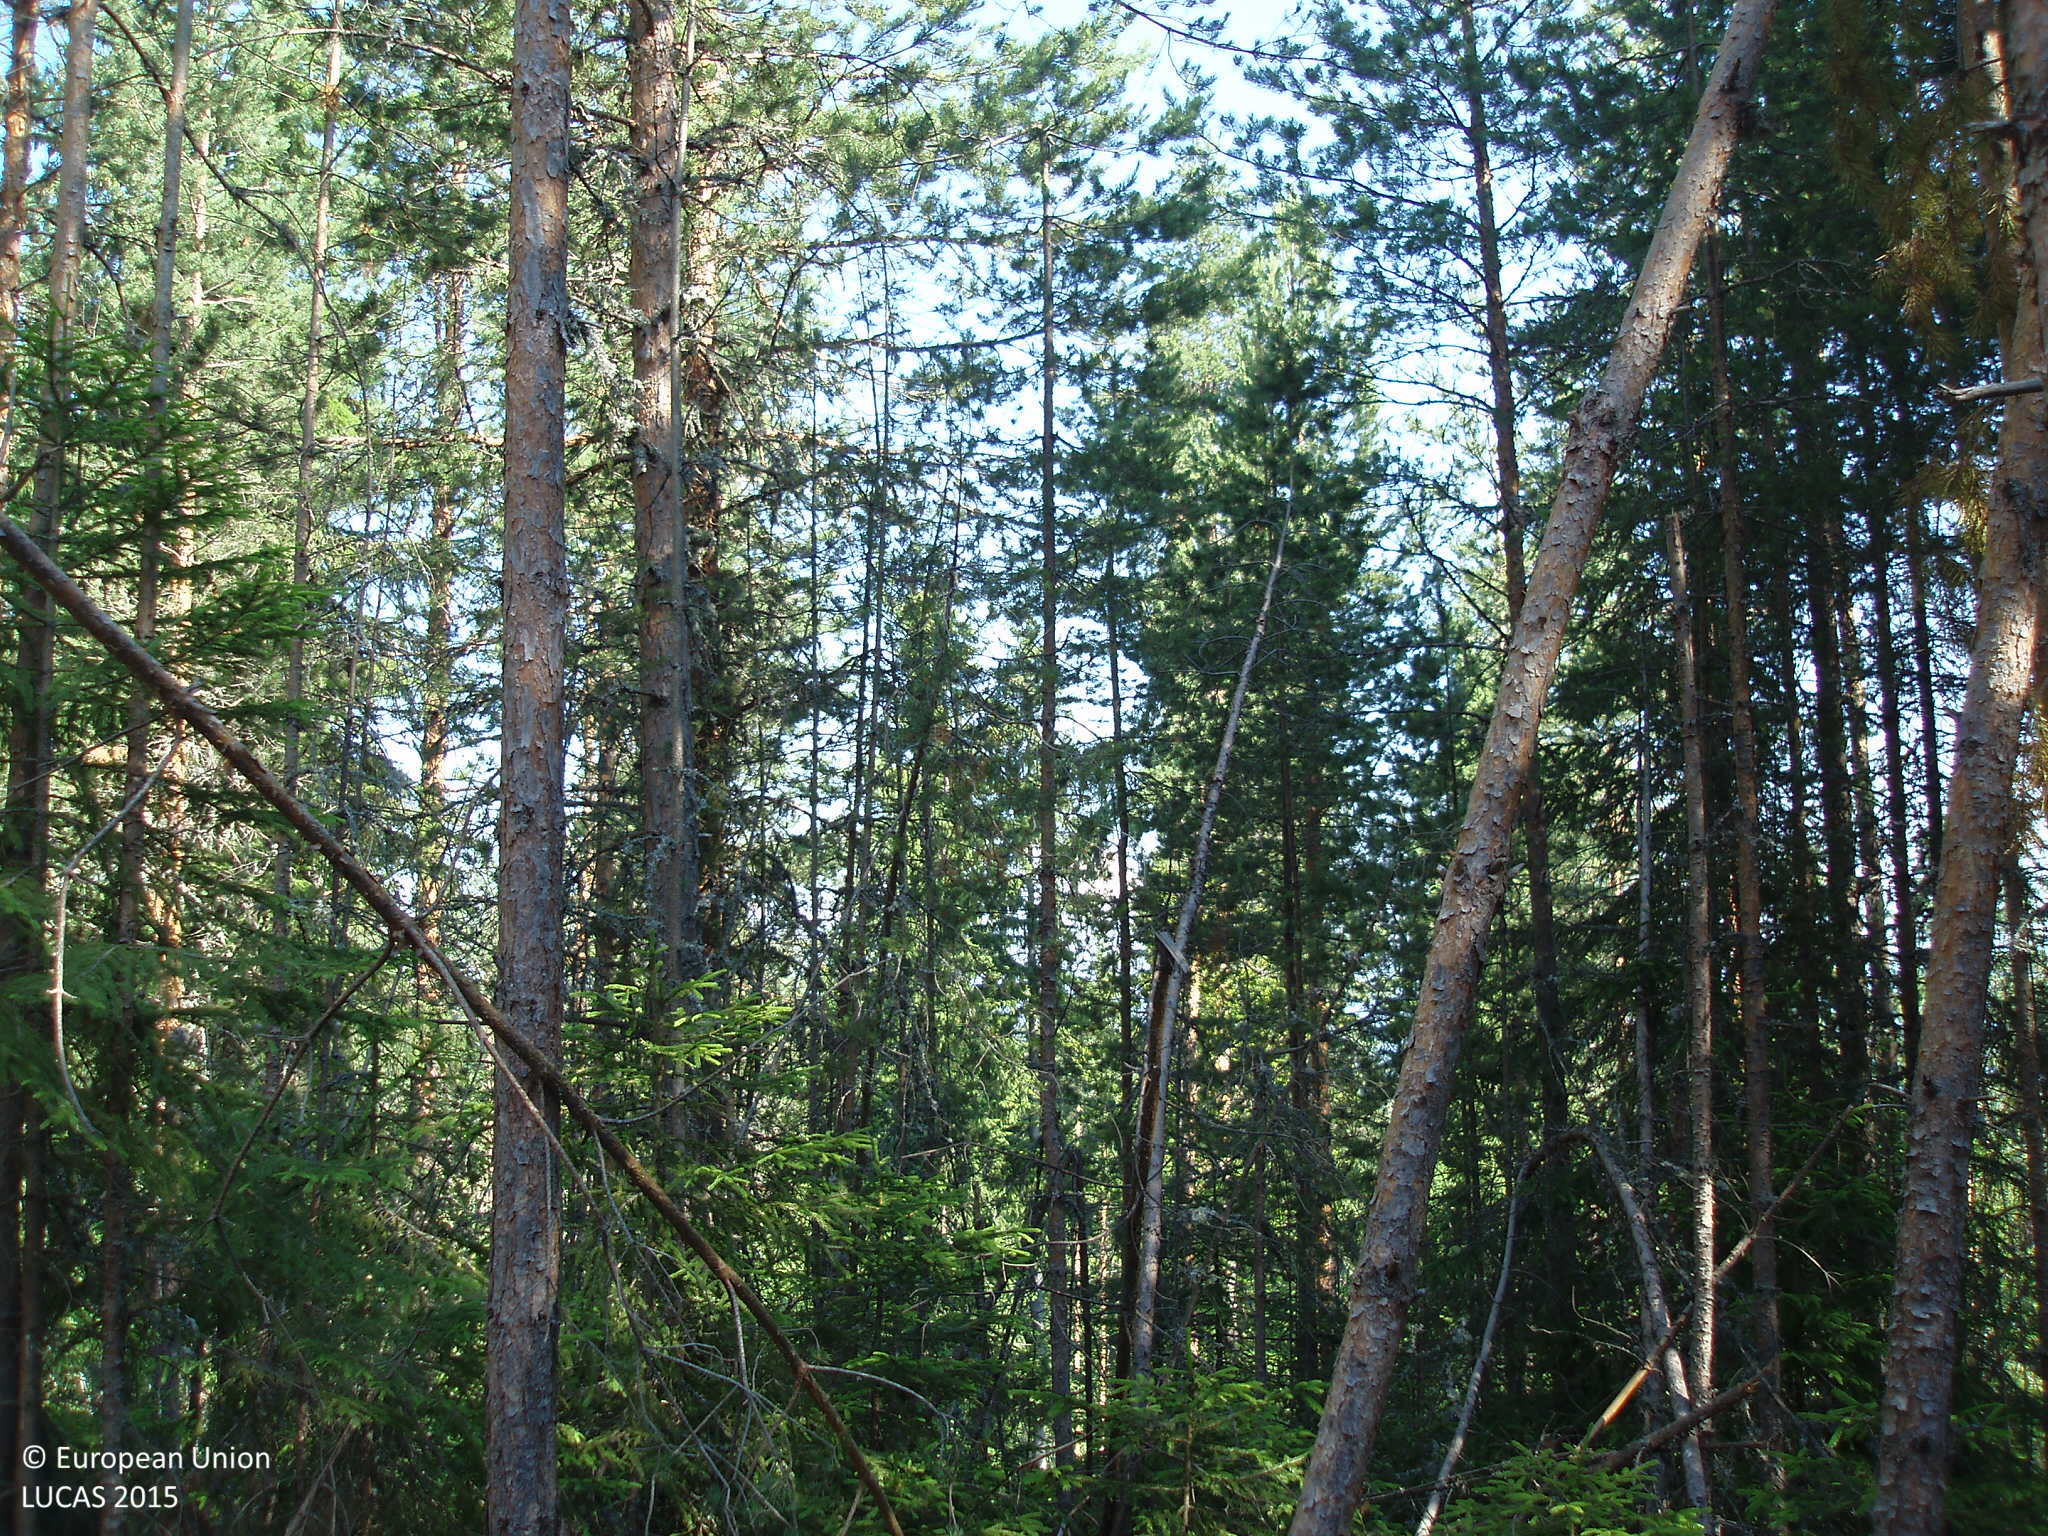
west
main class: Woodland
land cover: Pine dominated coniferous woodland
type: hemiboreal forest and nemoral coniferous forest and mixed broadleaved-coniferous forest
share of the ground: > 75 %
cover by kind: coniferous forest trees 100 %
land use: Forestry
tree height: > 5 m
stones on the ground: < 10 %
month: July
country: BG
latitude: 41.9749
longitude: 23.8280
